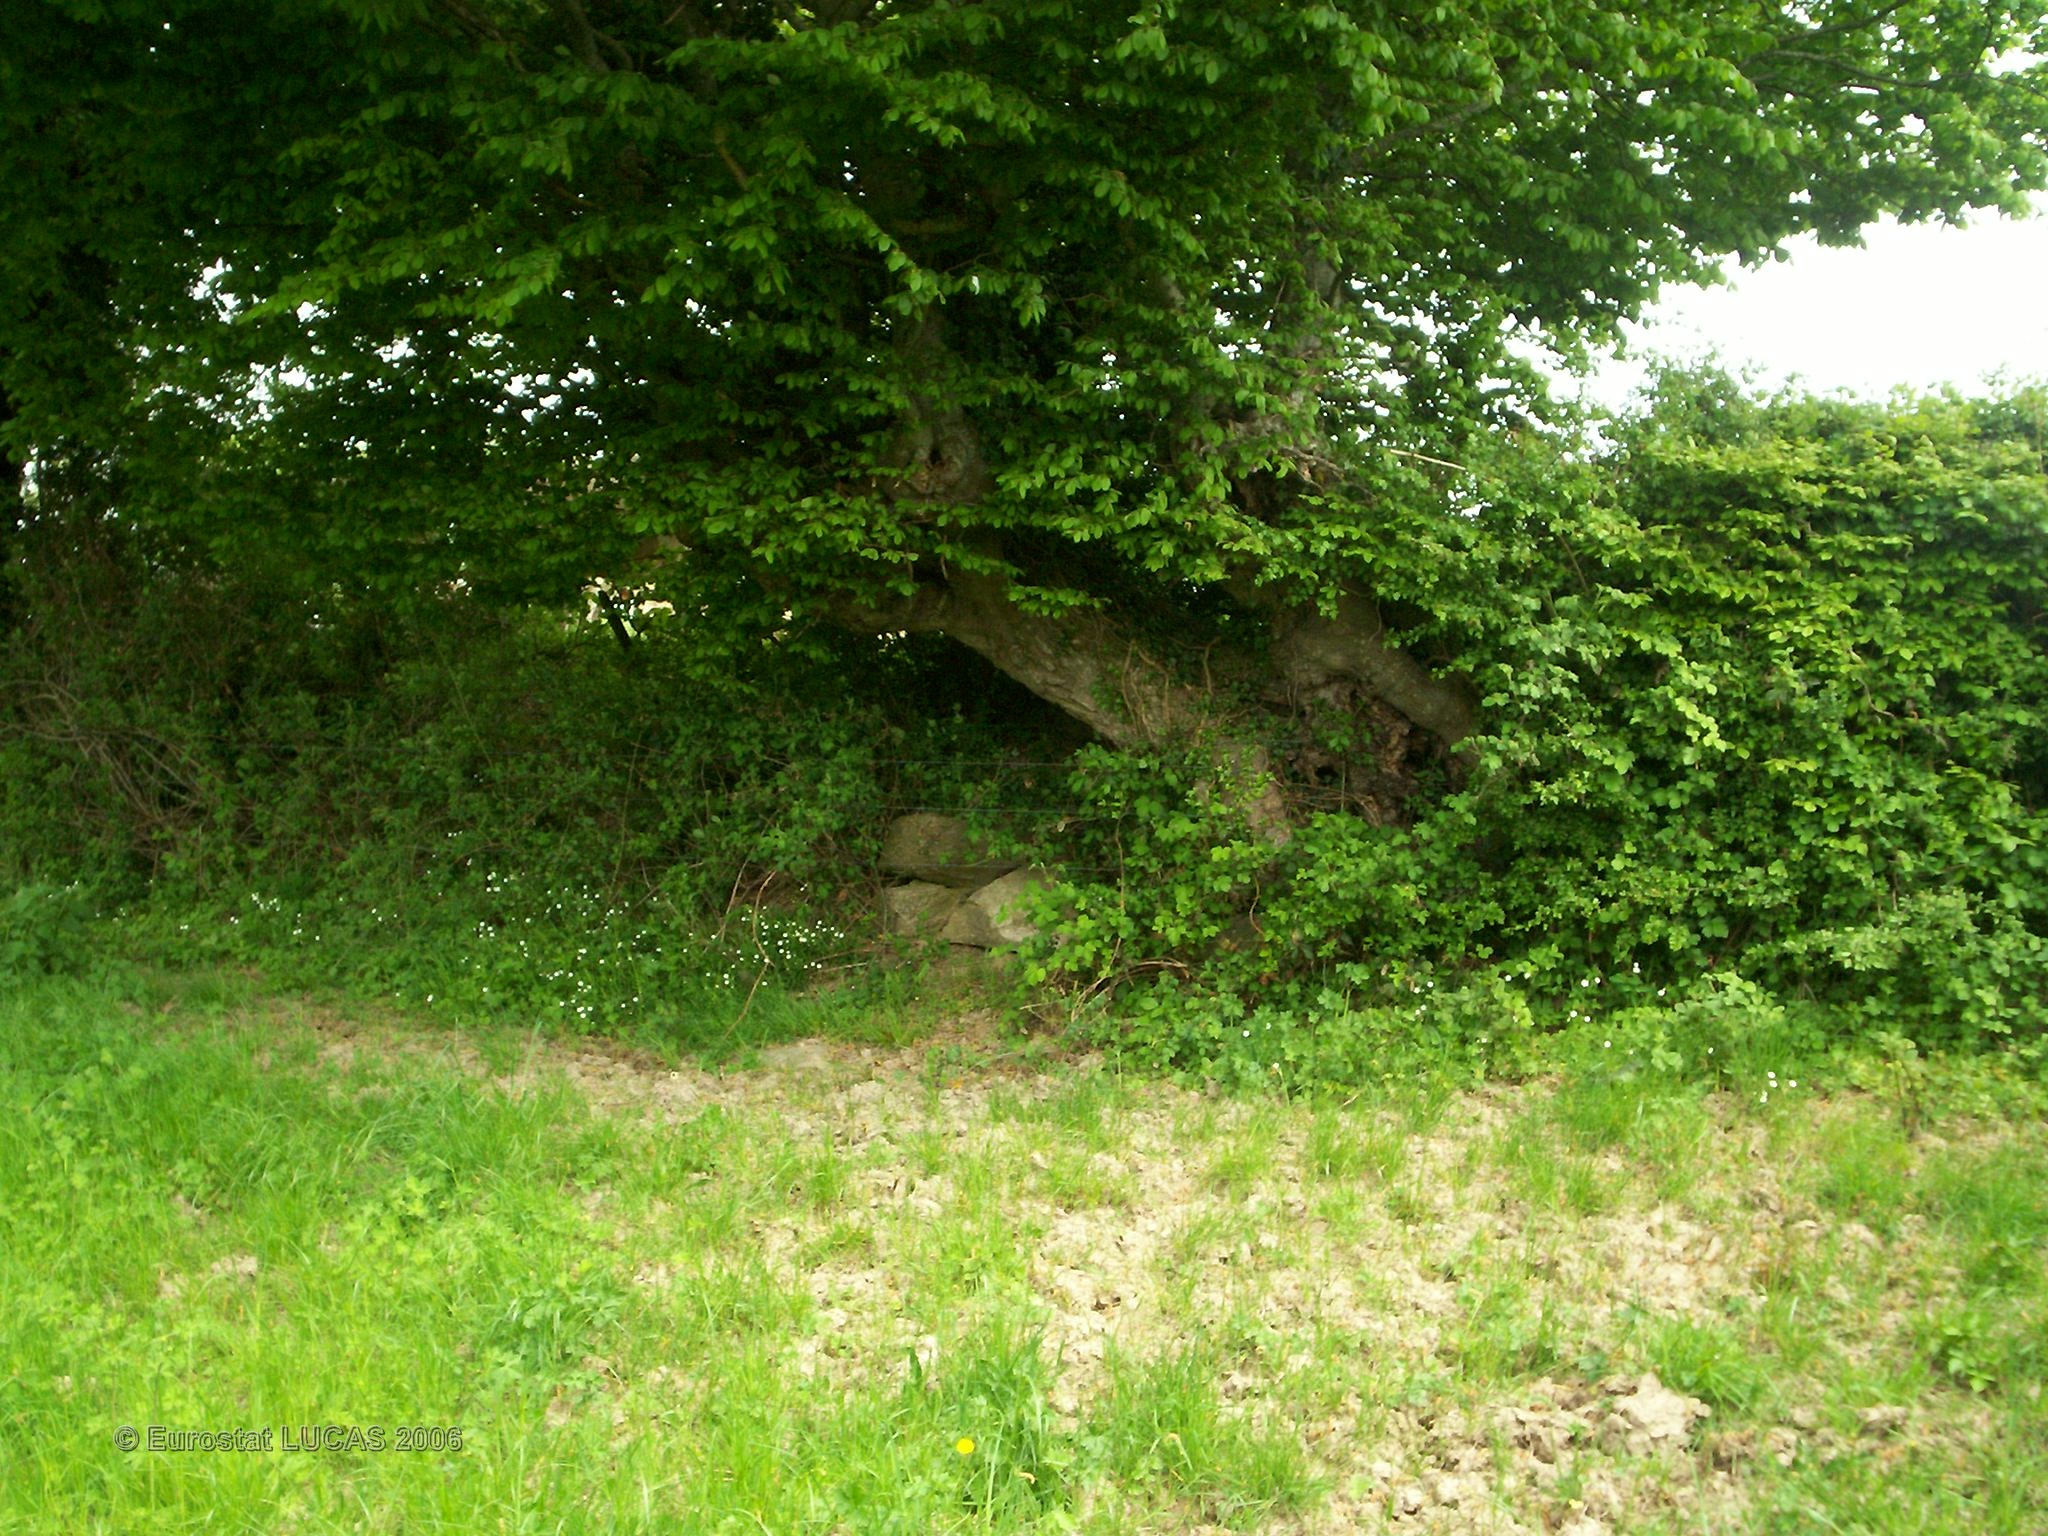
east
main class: Grassland
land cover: Grassland without tree/shrub cover
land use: Agriculture (excluding fallow land and kitchen gardens)
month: May
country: FR
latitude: 47.4043
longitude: 3.8889
